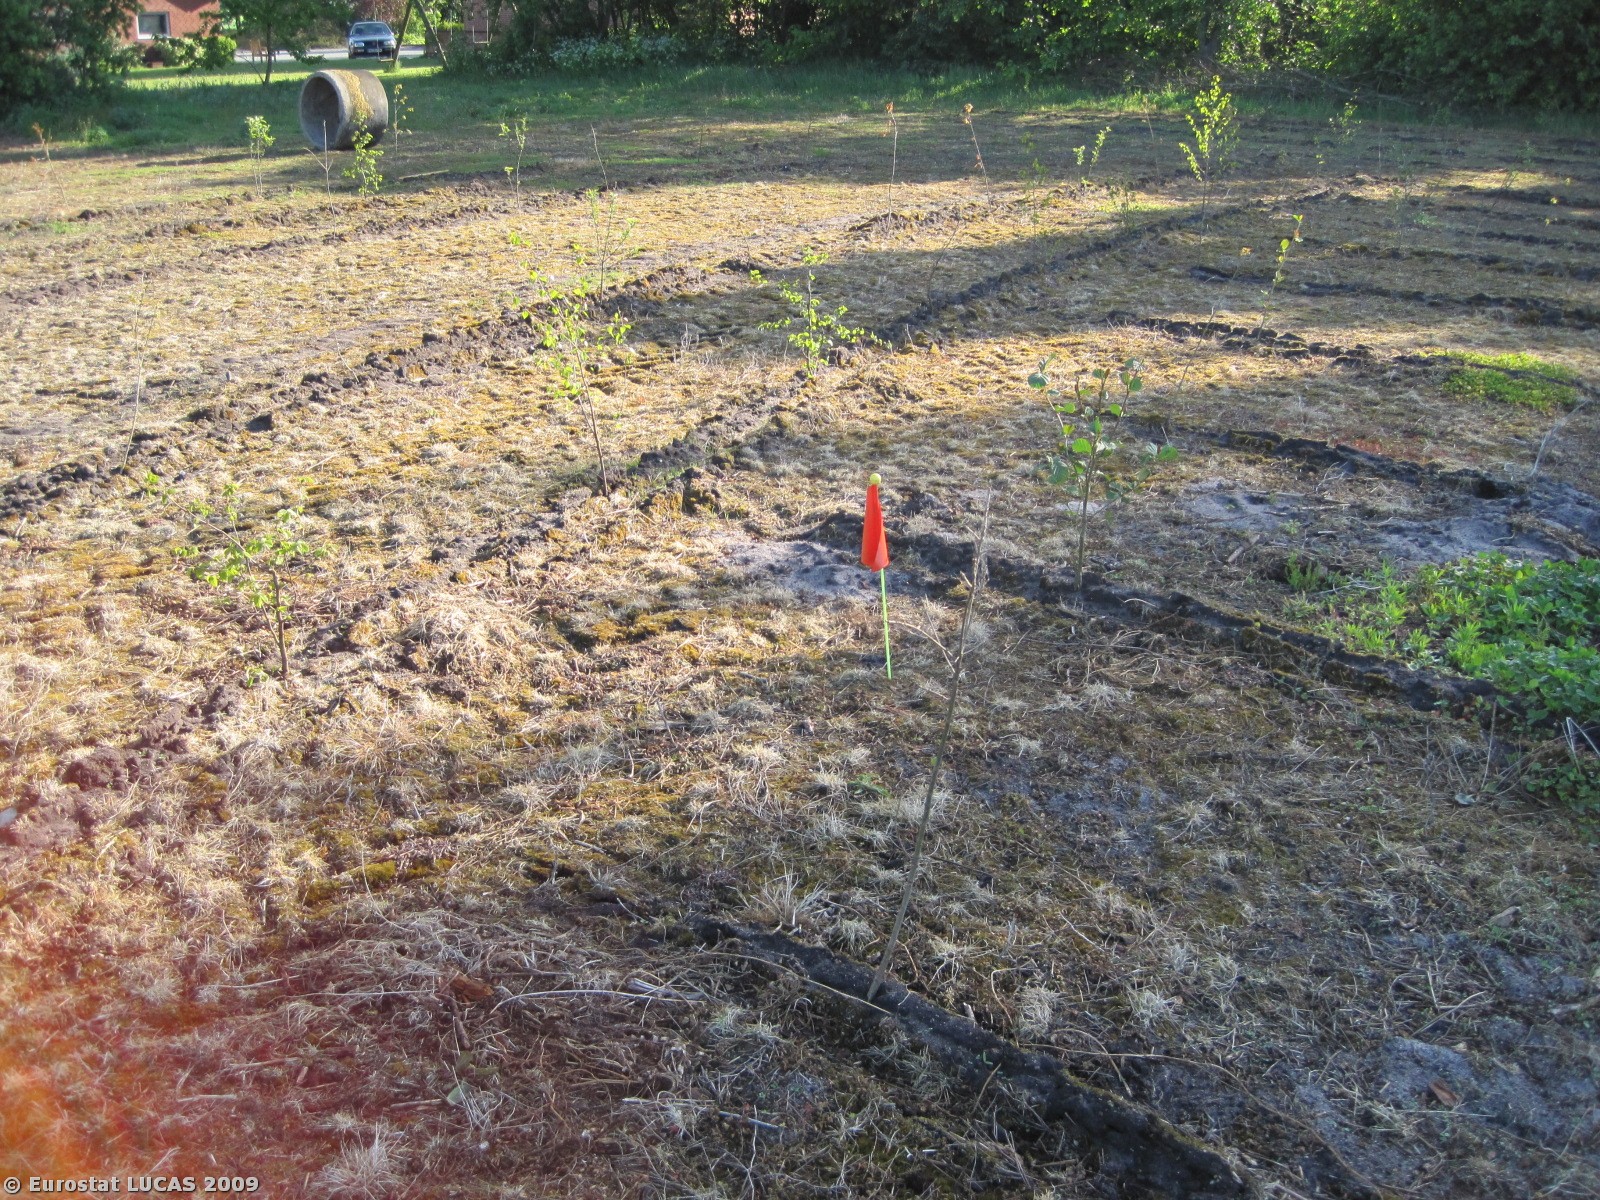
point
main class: Woodland
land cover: Broadleaved woodland
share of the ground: < 10 %
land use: Agriculture (excluding fallow land and kitchen gardens)
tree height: < 5 m
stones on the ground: < 10 %
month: May
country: DK
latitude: 56.4012
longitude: 9.2394
